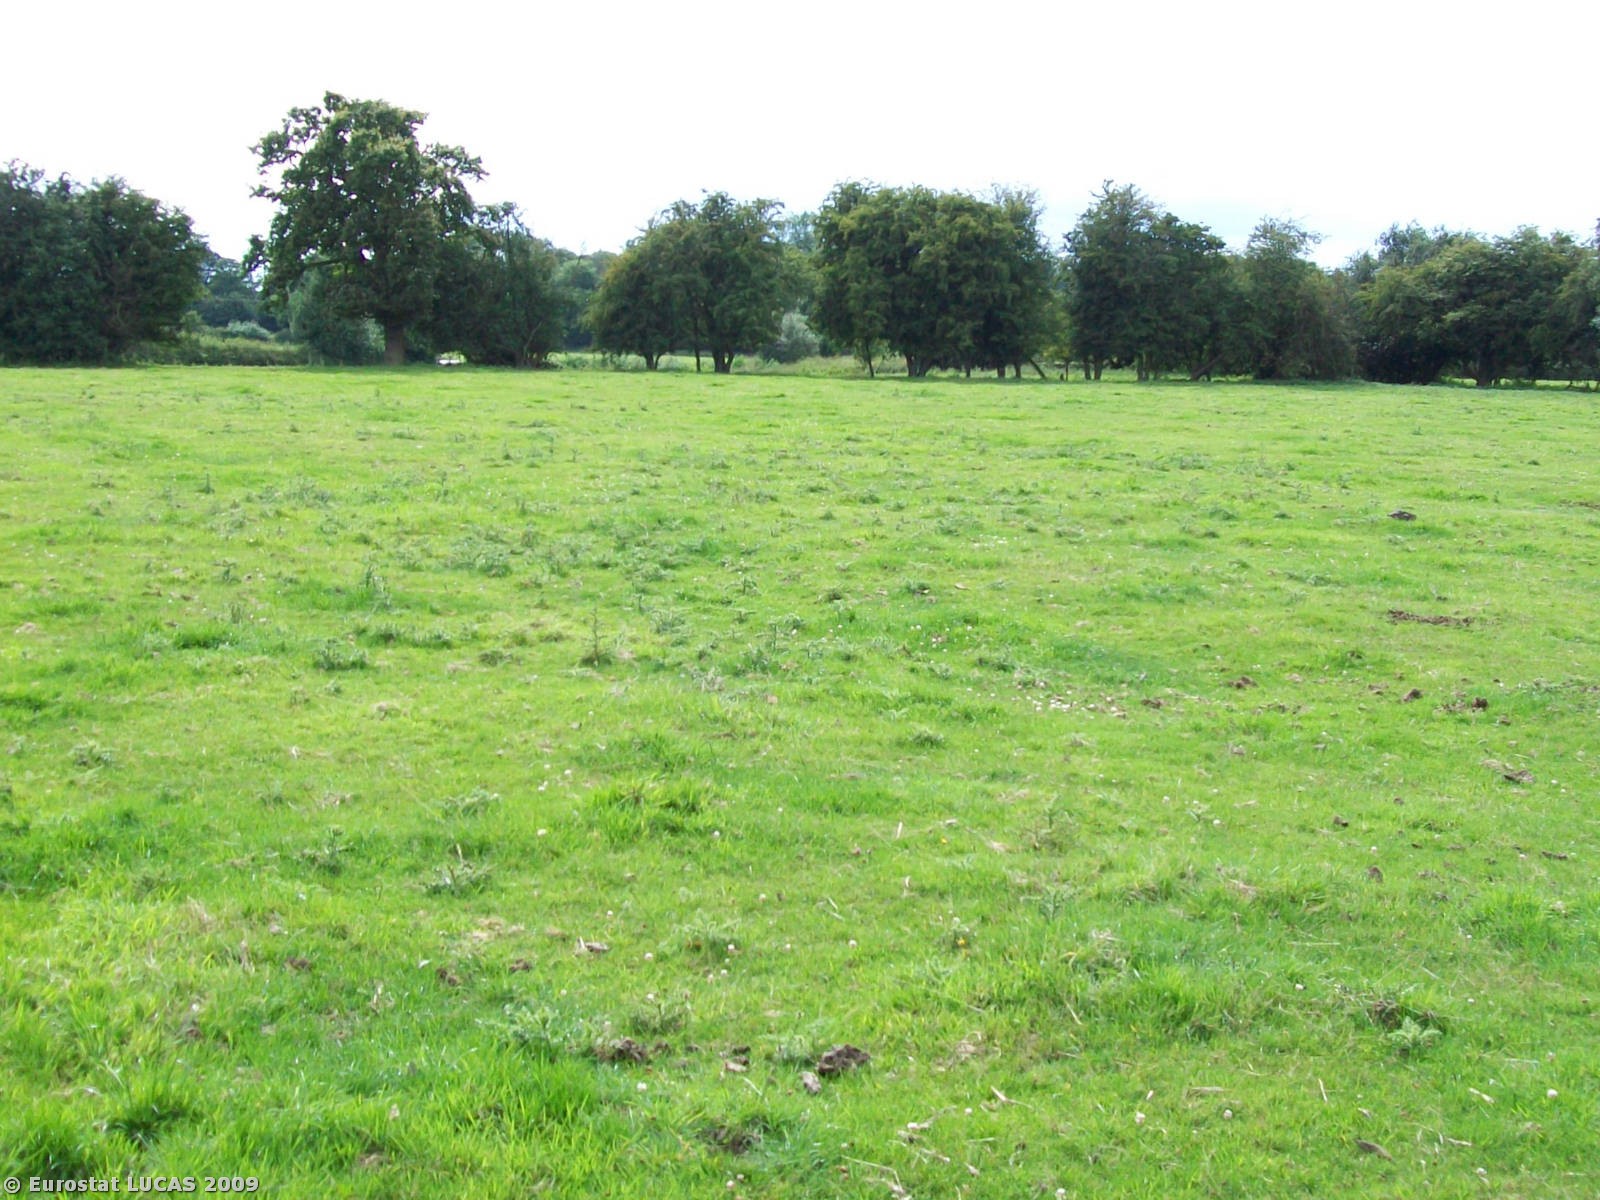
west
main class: Grassland
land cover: Grassland without tree/shrub cover
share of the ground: > 75 %
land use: Agriculture (excluding fallow land and kitchen gardens)
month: July
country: GB
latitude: 52.6273
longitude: -1.3805
